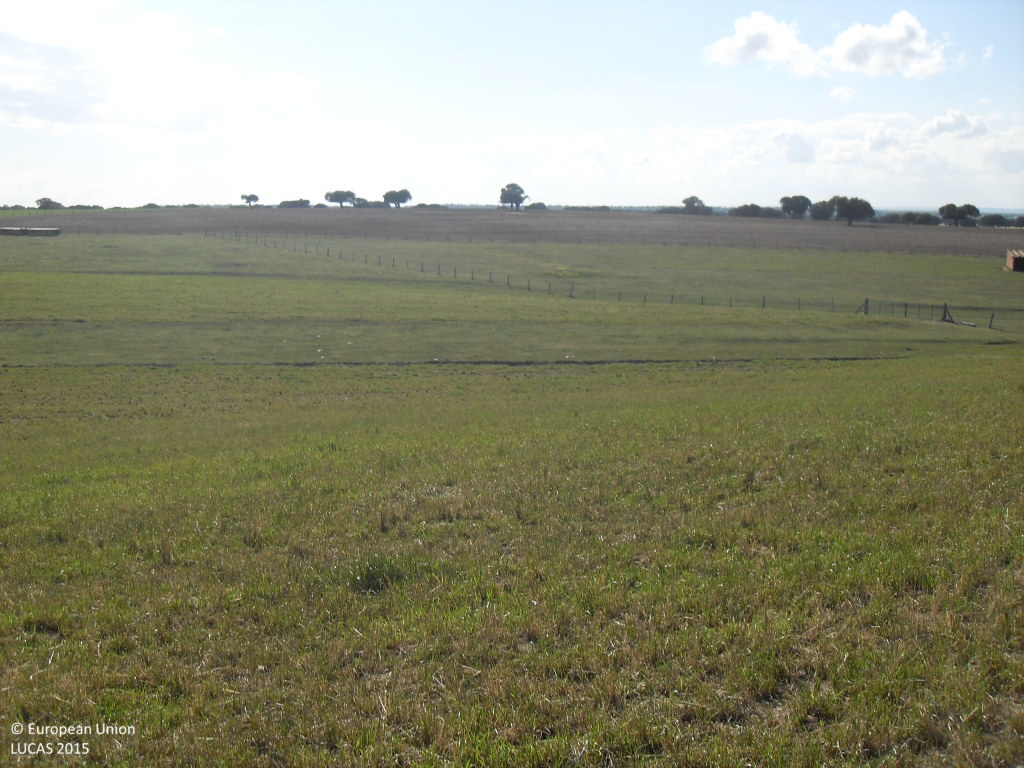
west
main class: Cropland
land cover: Rye
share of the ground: > 75 %
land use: Agriculture (excluding fallow land and kitchen gardens)
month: April
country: ES
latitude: 40.7265
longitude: -5.3288
